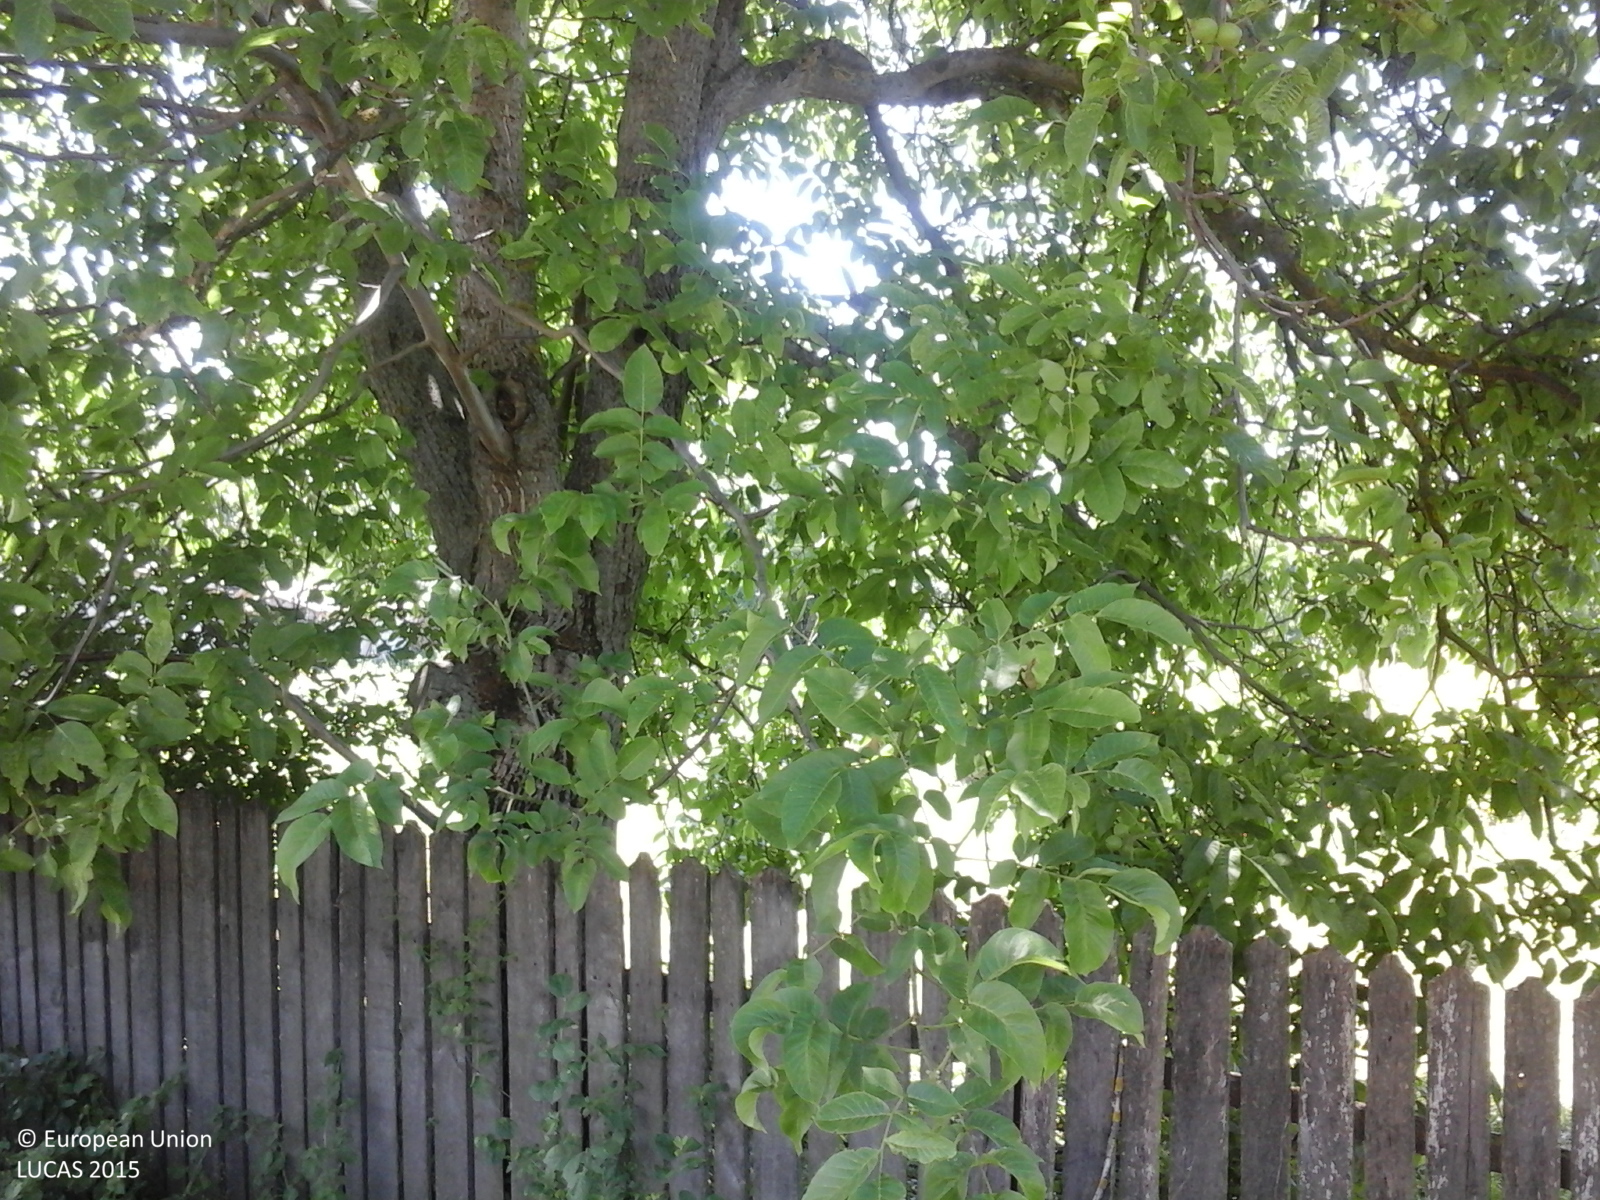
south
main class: Cropland
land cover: Vineyards
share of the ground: > 75 %
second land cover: Other bare soil
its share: > 75 %
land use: Kitchen garden
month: June
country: RO
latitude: 47.0314
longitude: 27.0363
